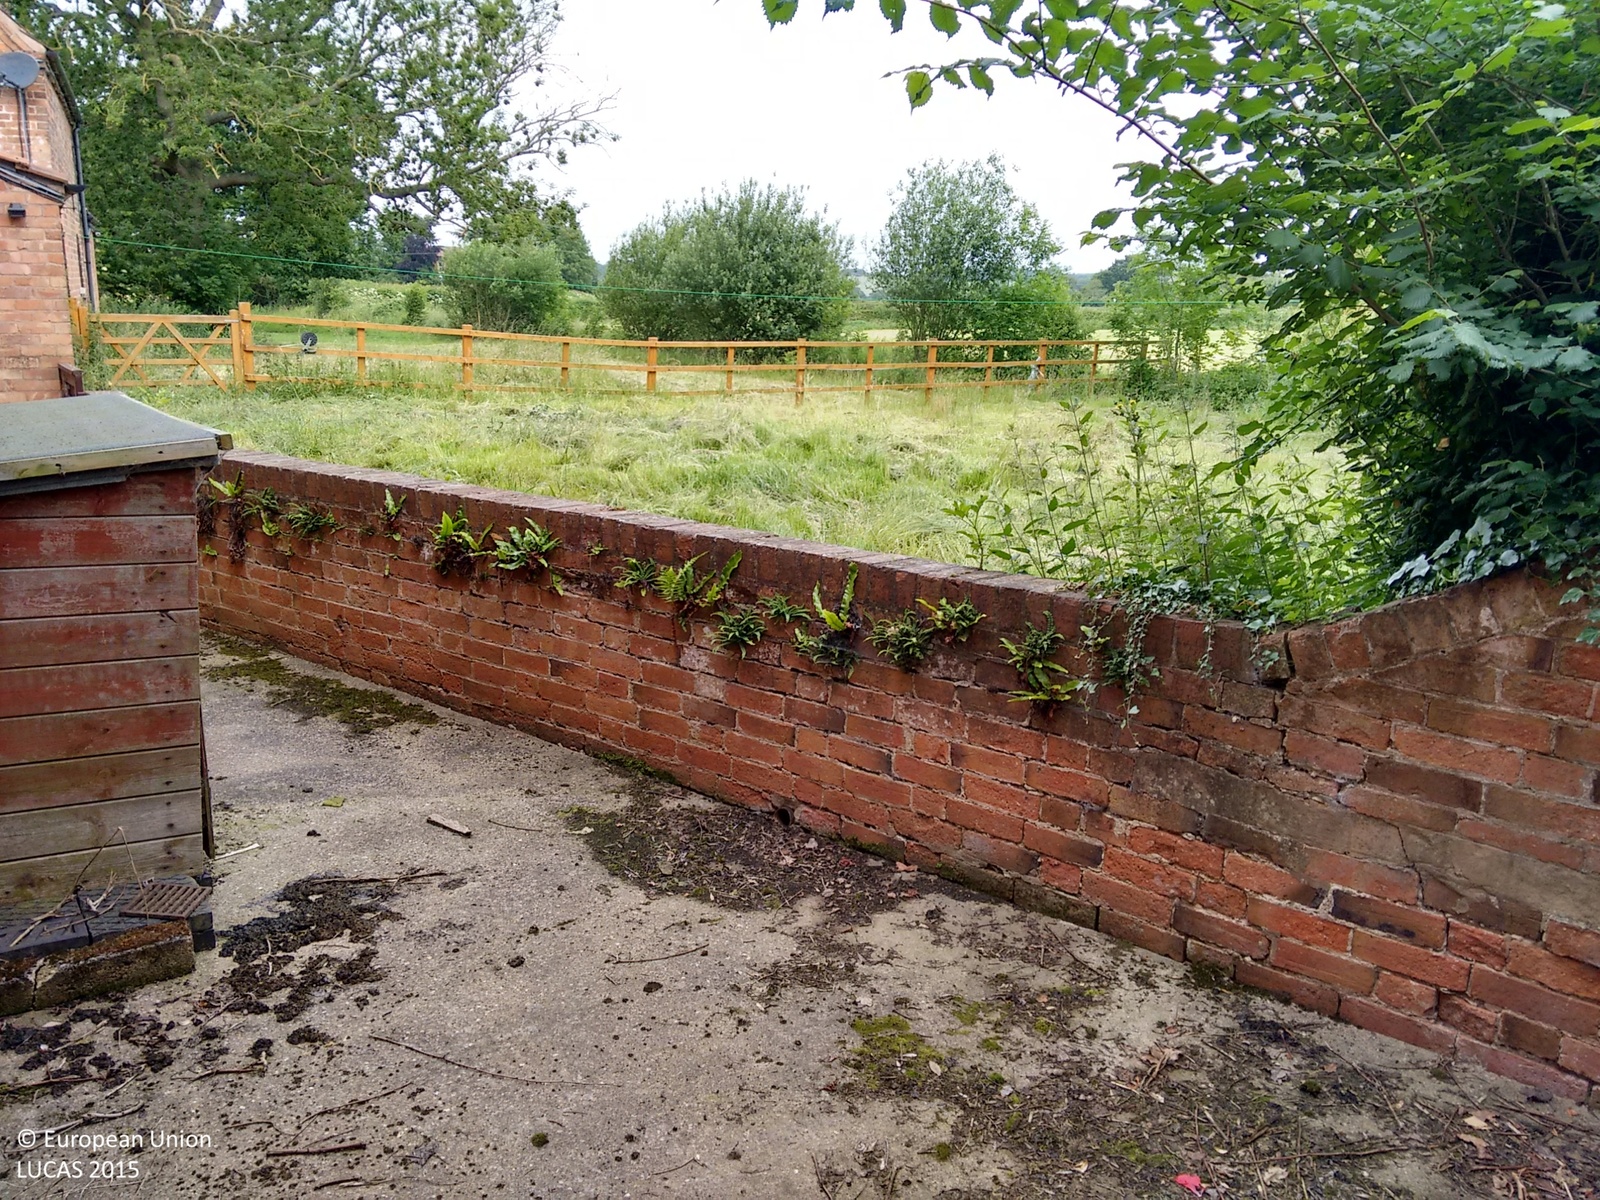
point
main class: Grassland
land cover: Grassland without tree/shrub cover
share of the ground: > 75 %
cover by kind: herbaceous plants 100 %
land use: Agriculture (excluding fallow land and kitchen gardens)
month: June
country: GB
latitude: 53.0110
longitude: -0.9683
